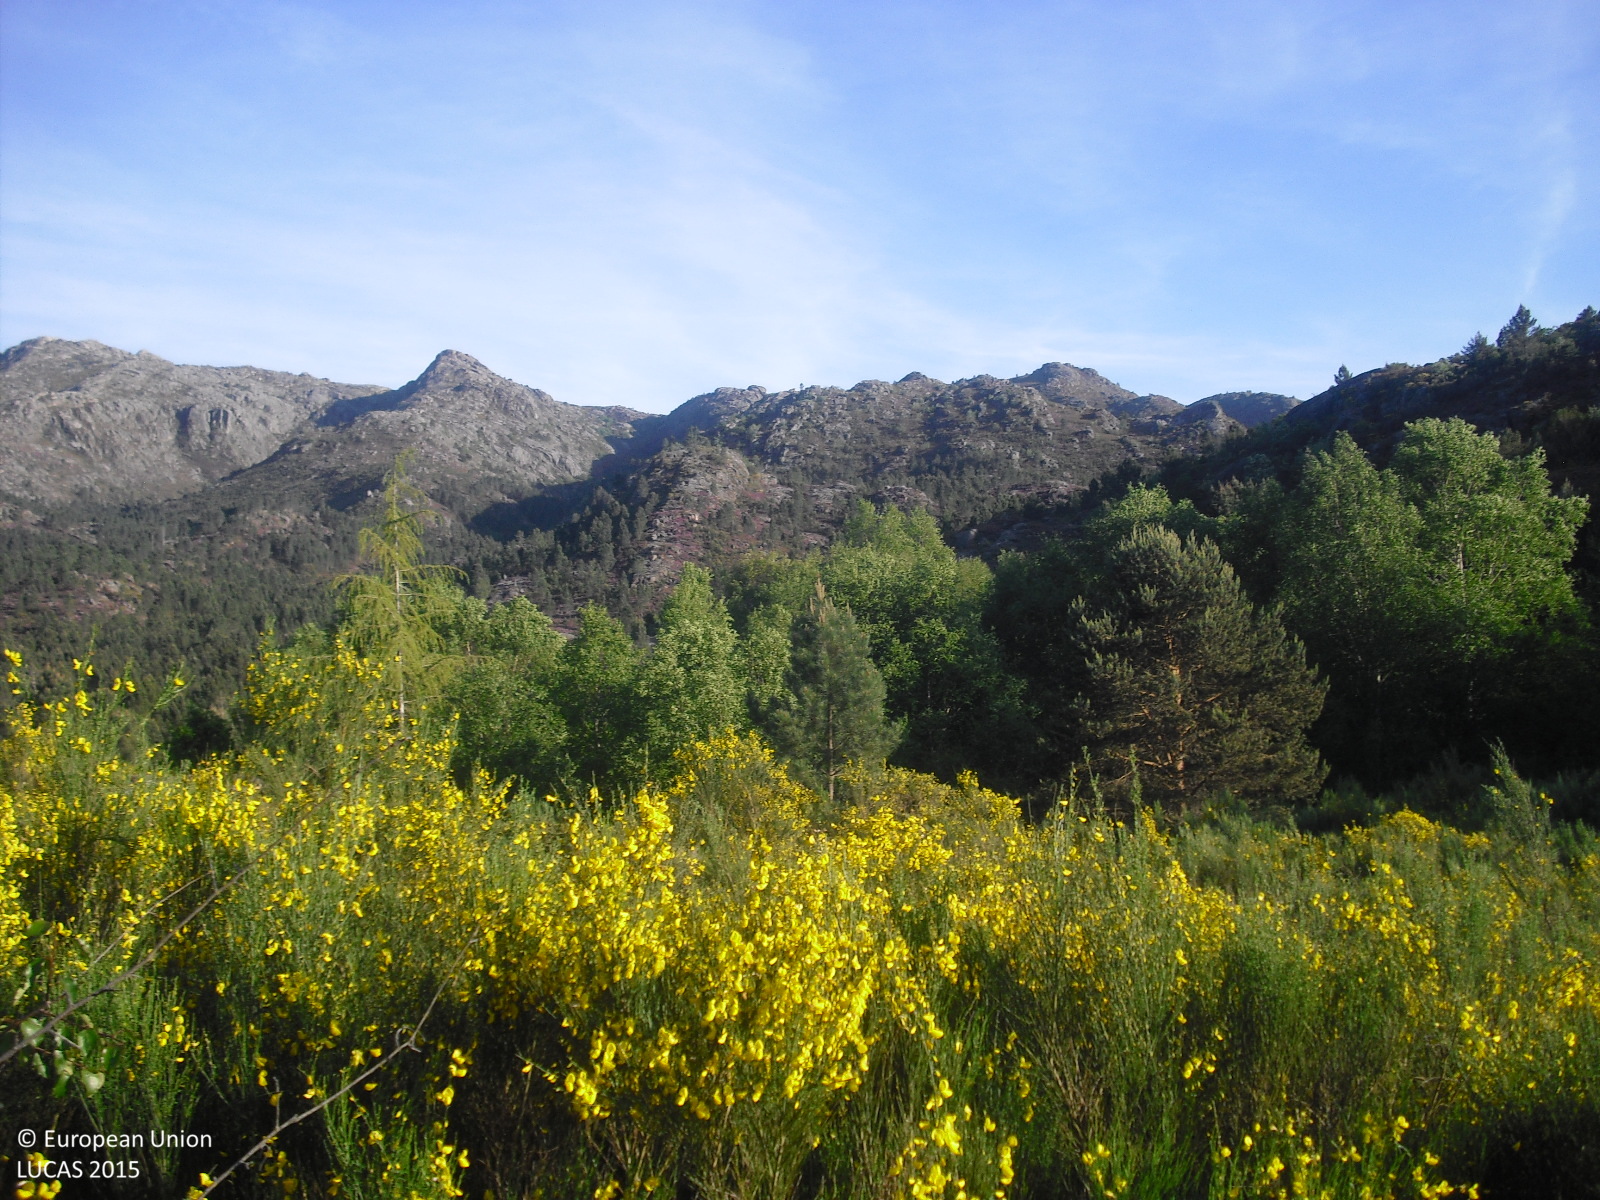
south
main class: Shrubland
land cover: Shrubland with sparse tree cover
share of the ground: > 75 %
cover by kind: shrubs 75 %, consolidated bare surface 20 %, coniferous forest trees 5 %
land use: Semi-natural and natural areas not in use
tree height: < 5 m
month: May
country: ES
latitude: 41.8373
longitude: -8.1040
